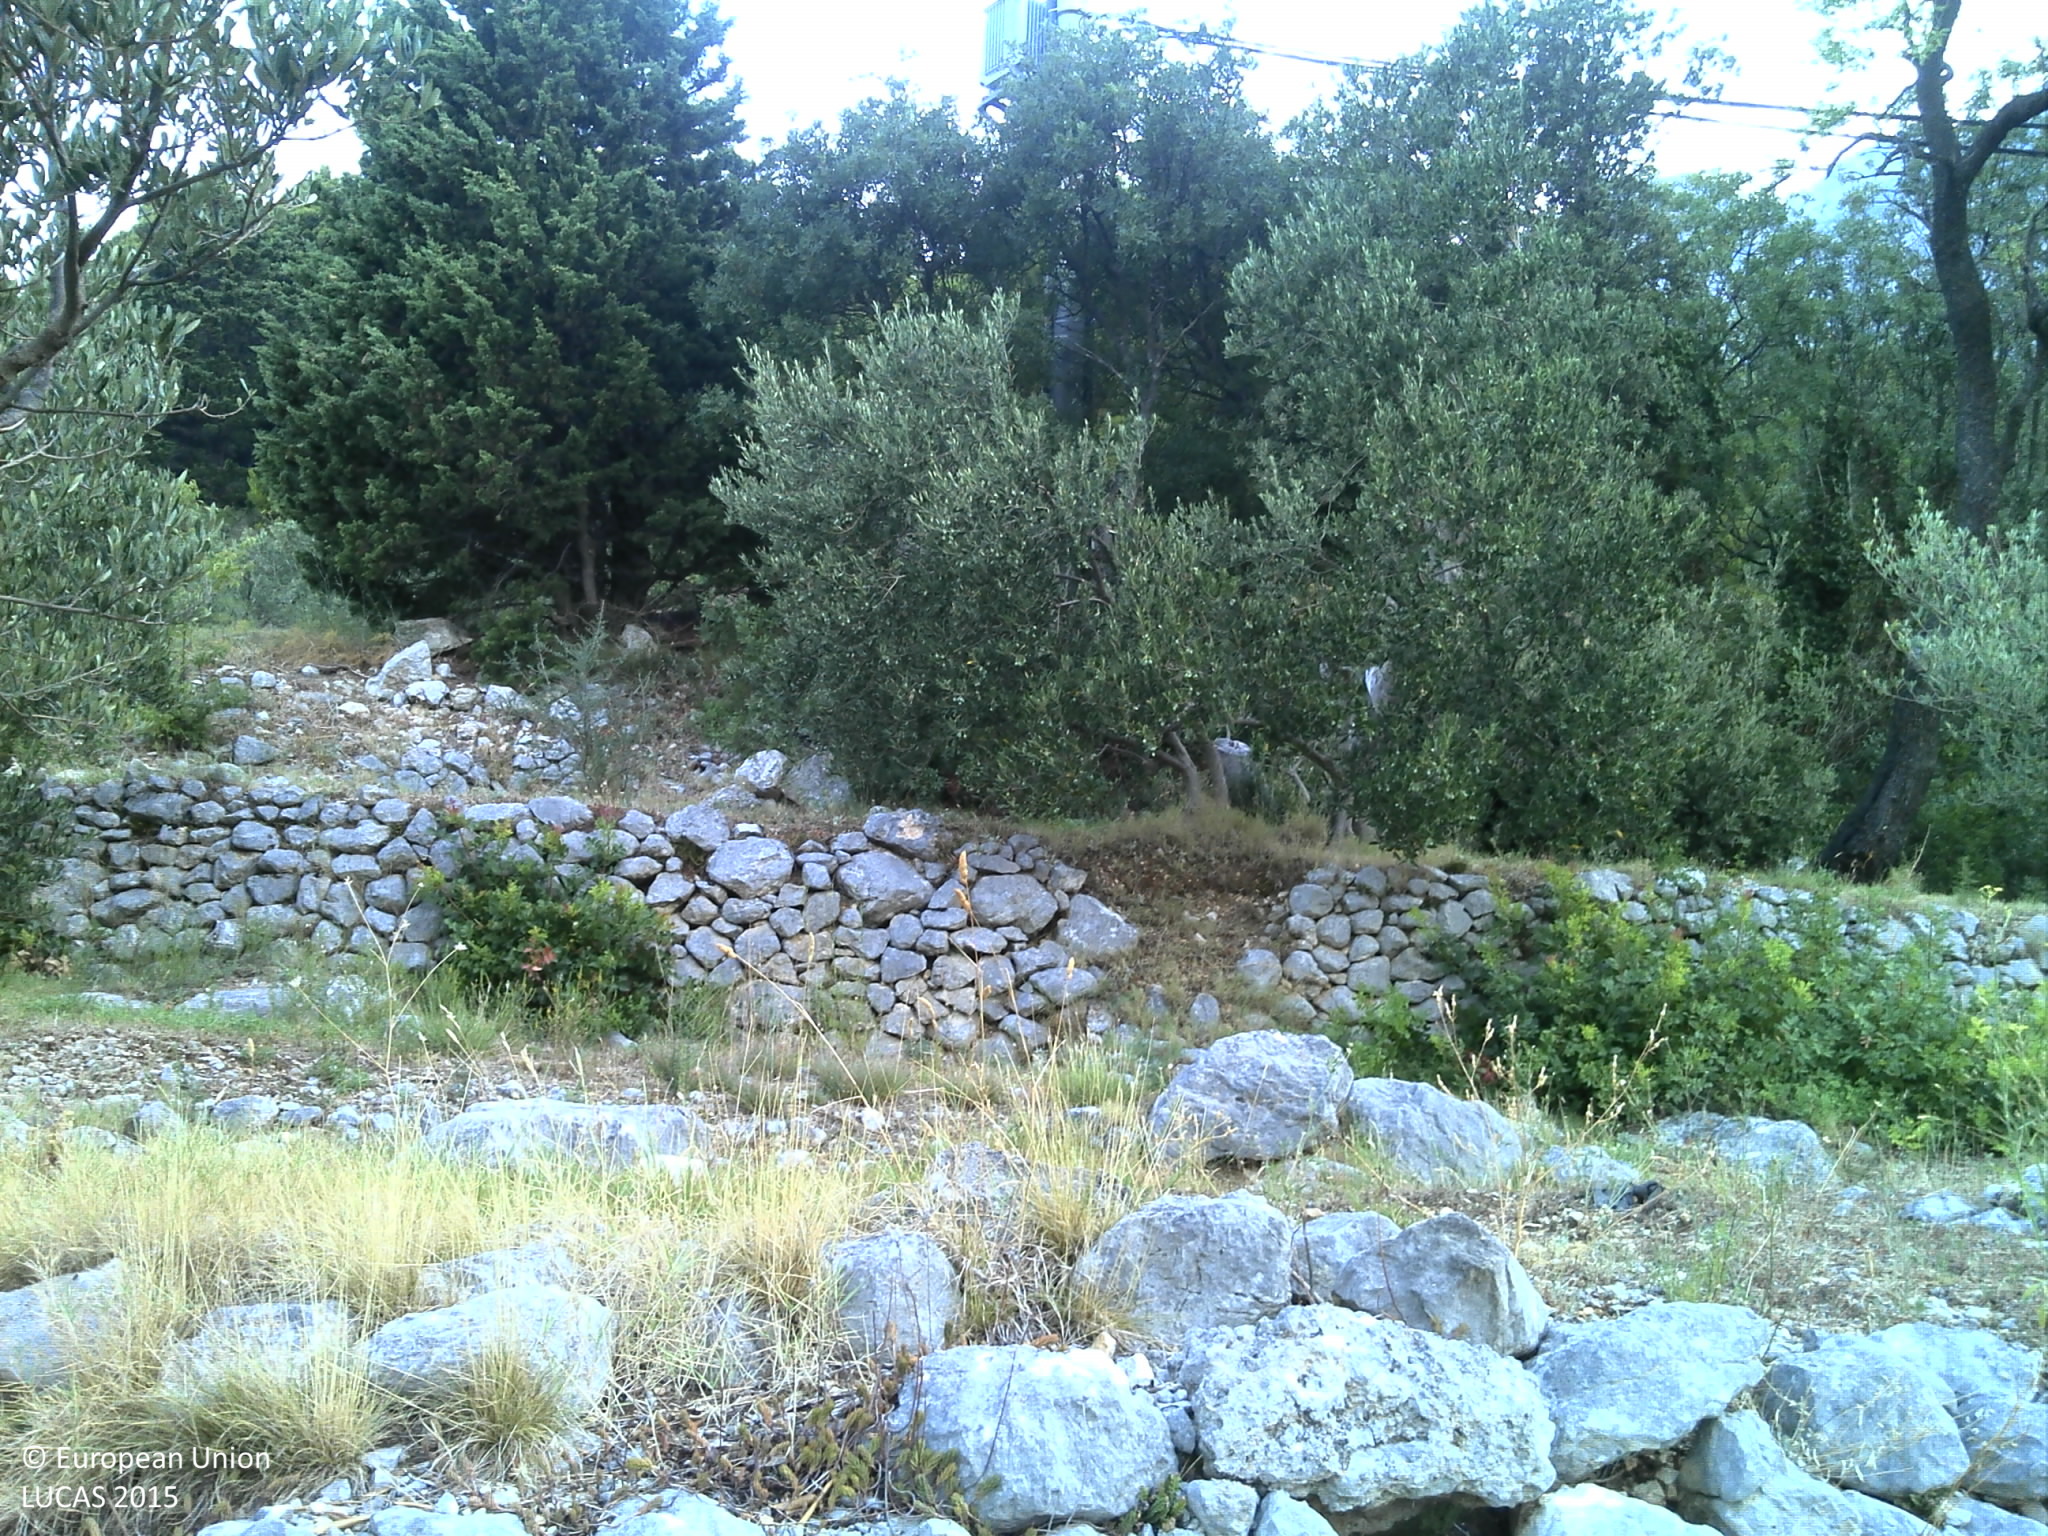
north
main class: Cropland
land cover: Olive groves
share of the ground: > 75 %
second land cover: Grassland without tree/shrub cover
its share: > 75 %
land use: Agriculture (excluding fallow land and kitchen gardens)
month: August
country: HR
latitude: 43.2973
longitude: 17.0292
